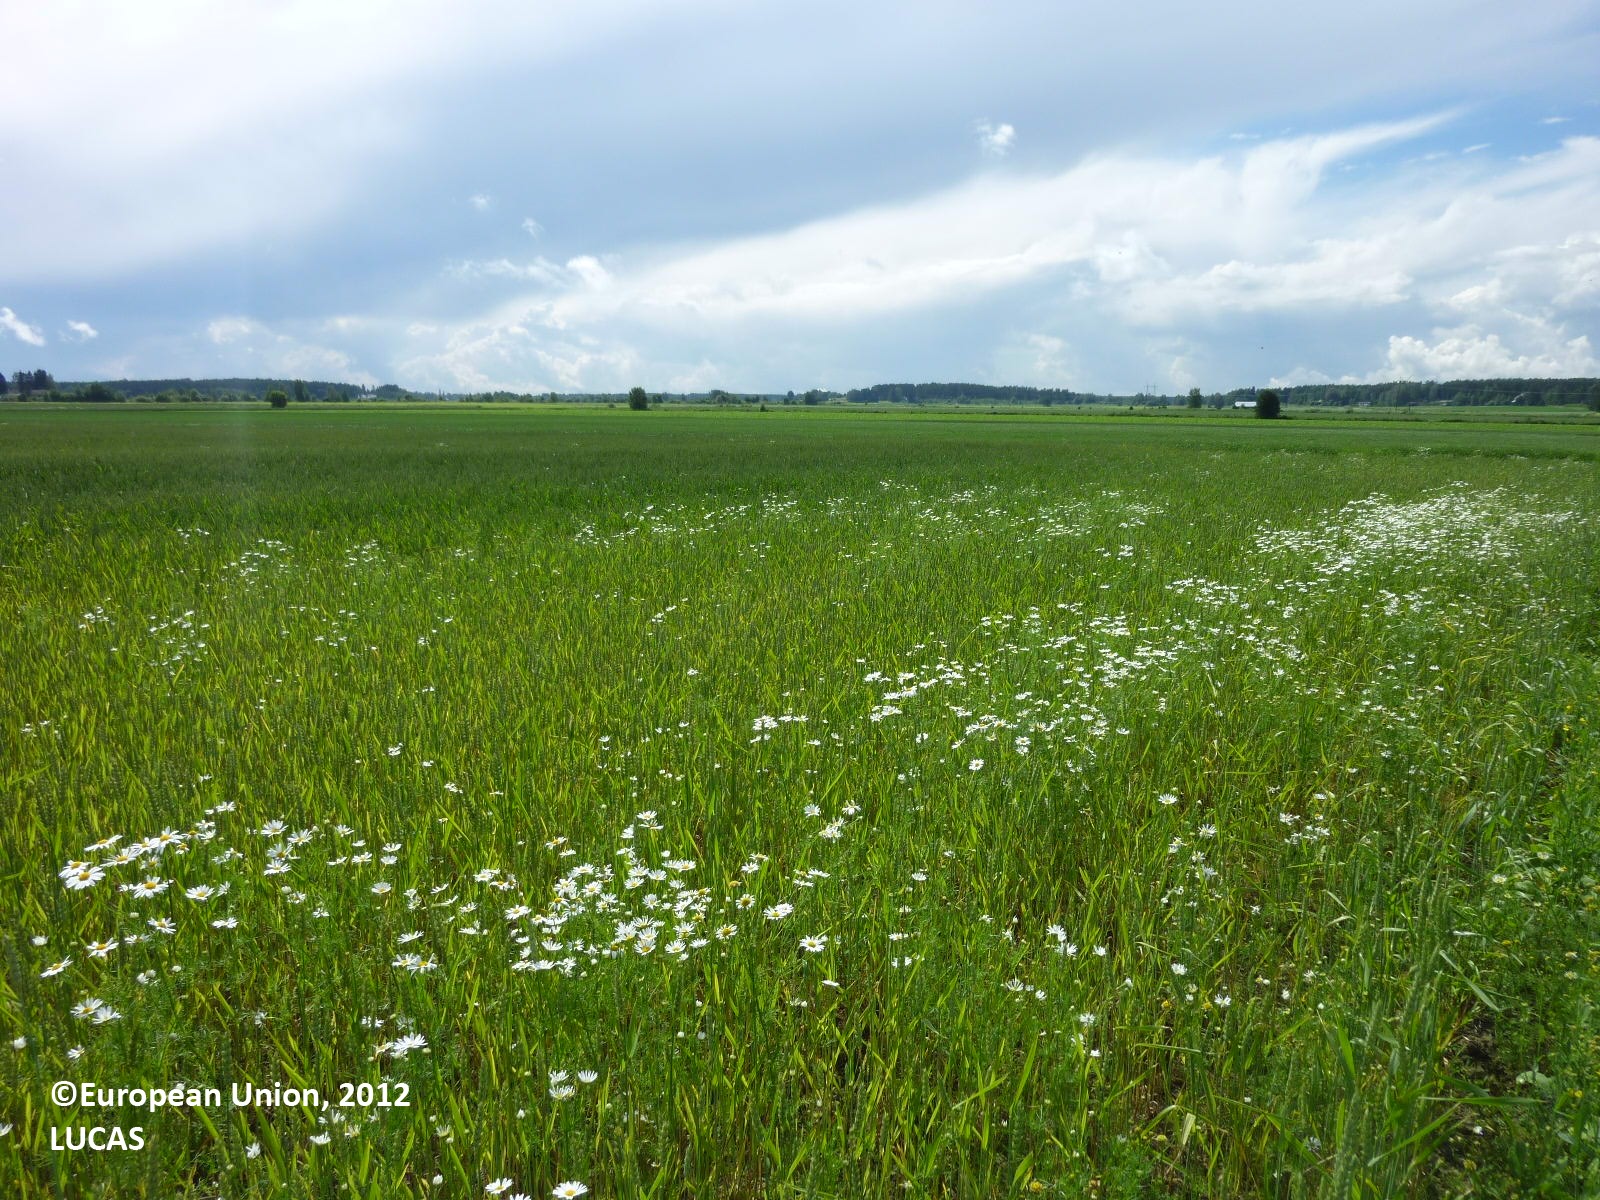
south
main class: Cropland
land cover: Common wheat
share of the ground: > 75 %
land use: Agriculture (excluding fallow land and kitchen gardens)
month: July
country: FI
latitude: 61.2471
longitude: 22.0794
